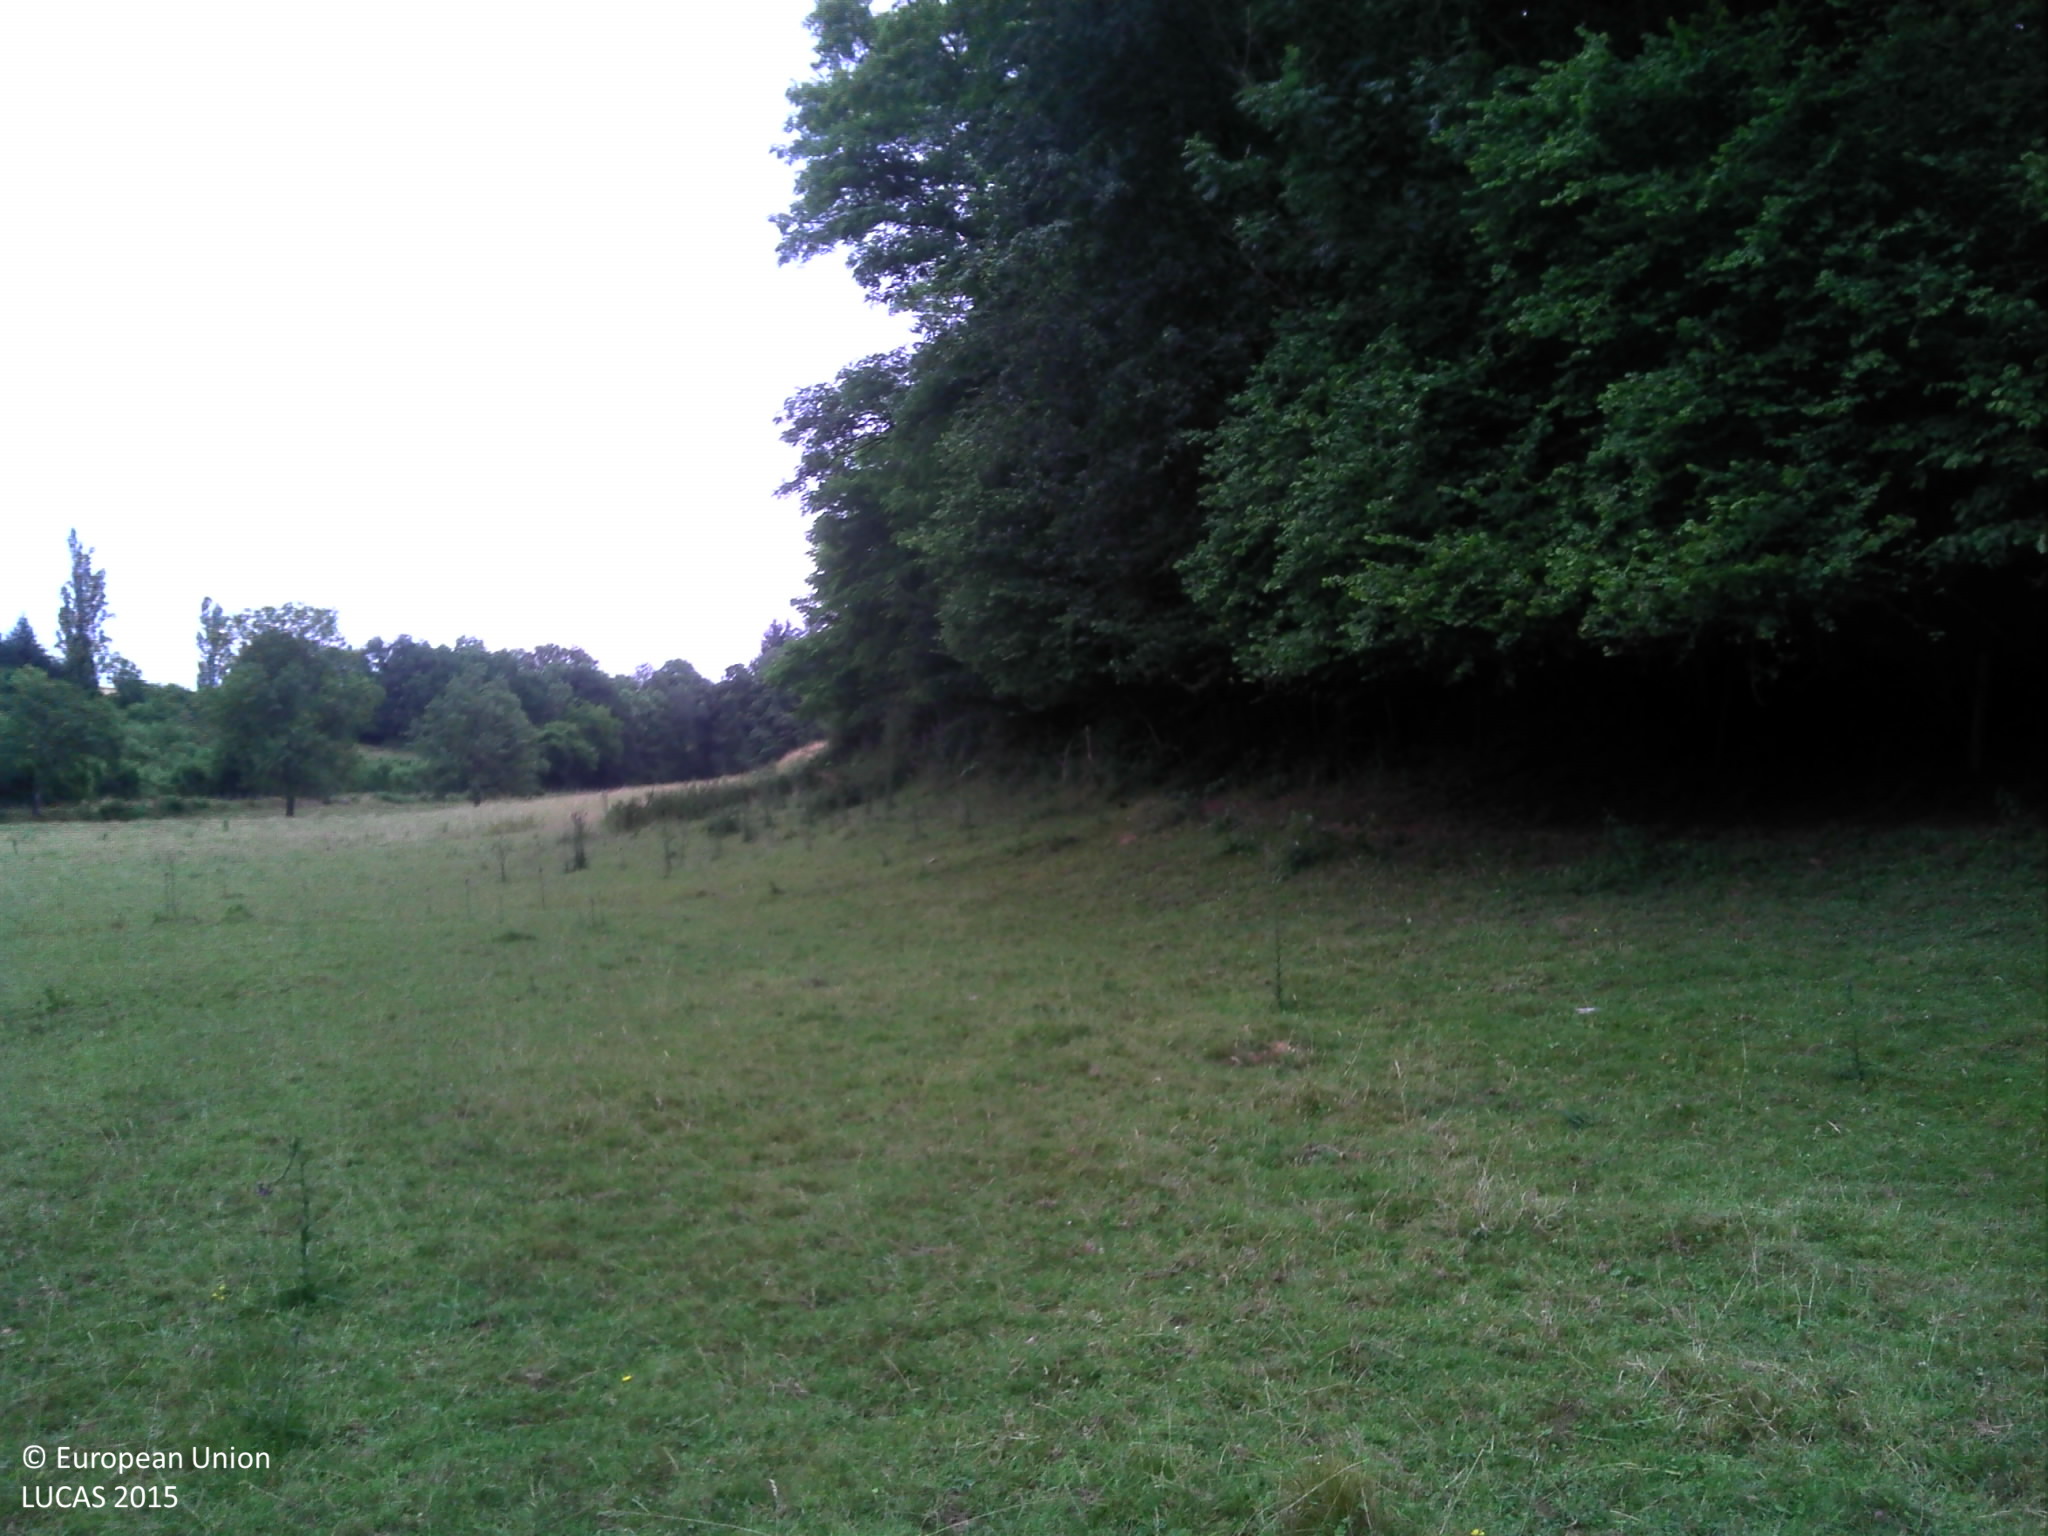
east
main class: Grassland
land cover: Grassland without tree/shrub cover
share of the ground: > 75 %
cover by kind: herbaceous plants 100 %
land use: Agriculture (excluding fallow land and kitchen gardens)
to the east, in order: Grassland without tree/shrub cover; Fences; Broadleaved woodland; Fences; Grassland without tree/shrub cover; Broadleaved woodland
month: June
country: FR
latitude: 46.5160
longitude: 4.4878
